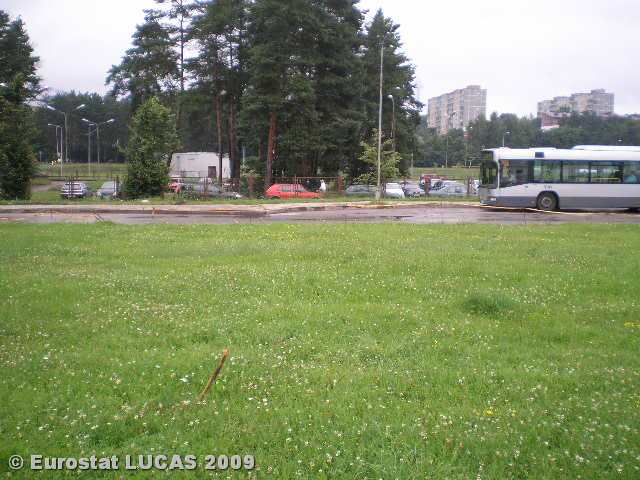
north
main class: Grassland
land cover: Grassland without tree/shrub cover
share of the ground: > 75 %
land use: Community services
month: July
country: LT
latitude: 54.6688
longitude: 25.2062
